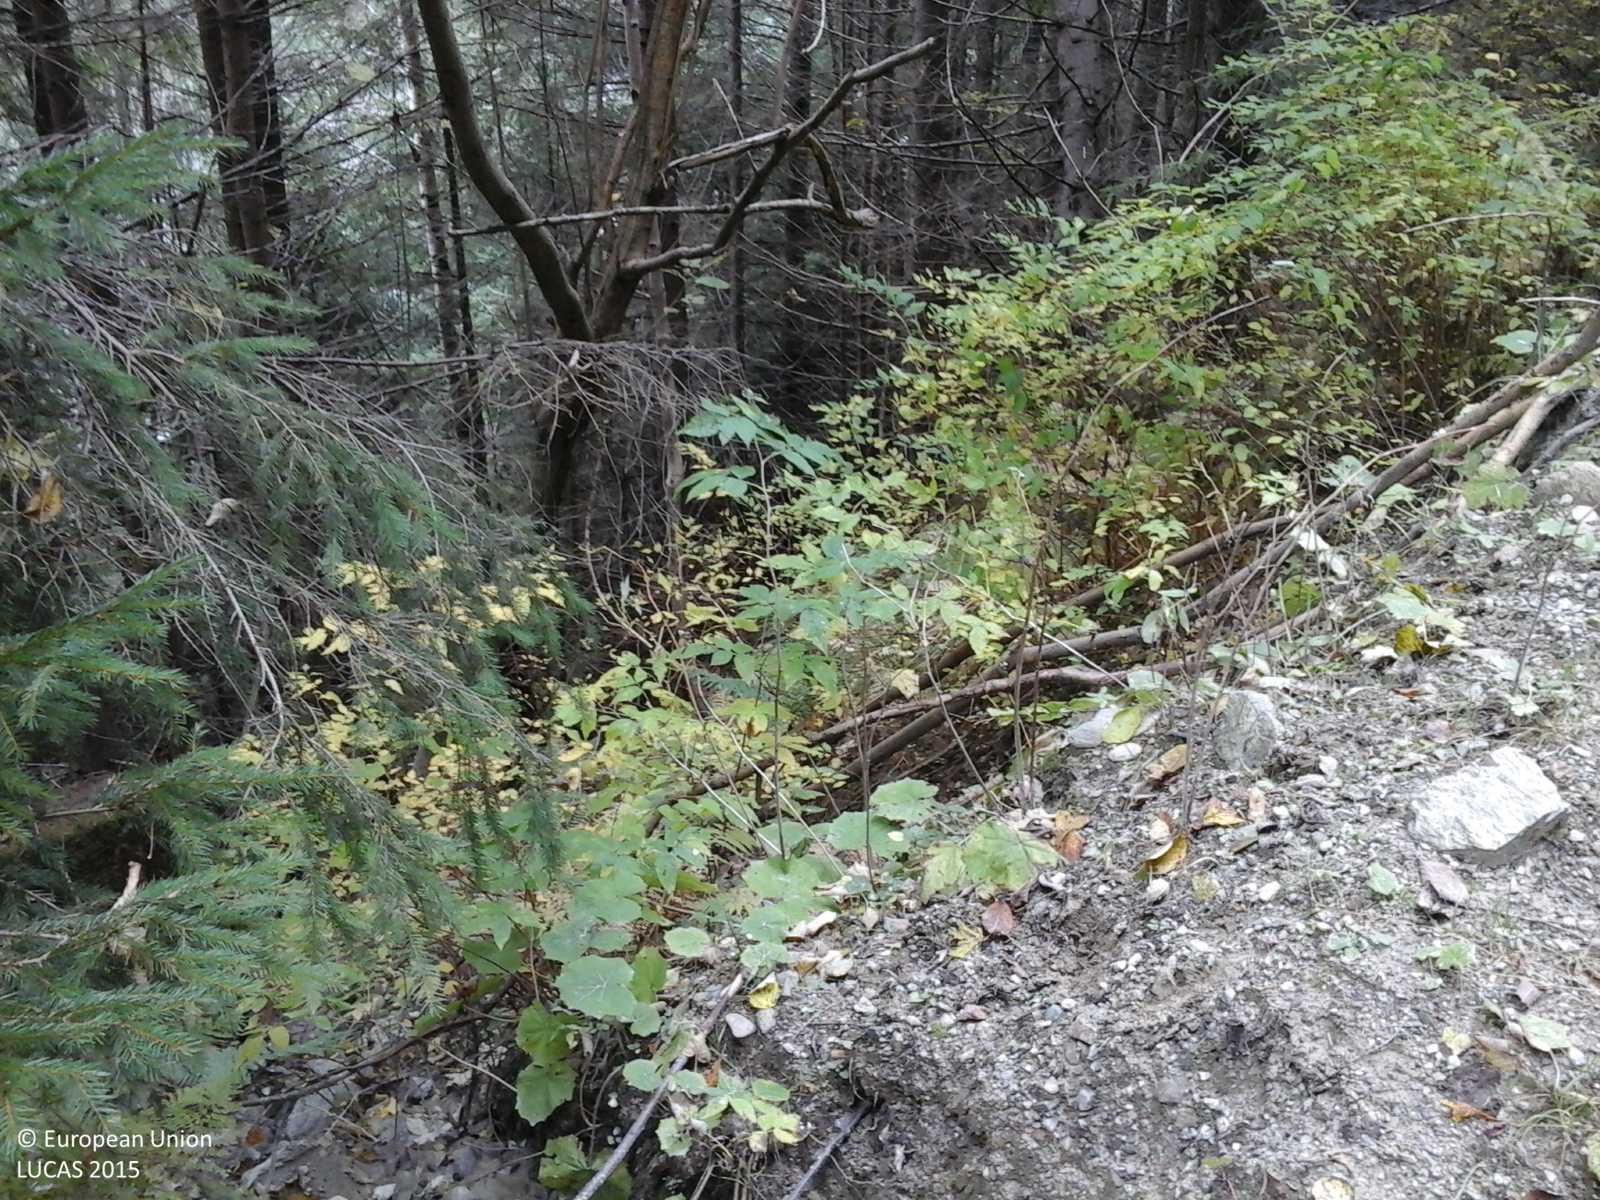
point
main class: Woodland
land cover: Spruce dominated mixed woodland
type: alpine coniferous forest
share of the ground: > 75 %
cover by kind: coniferous forest trees 75 %, broadleaved forest trees 25 %
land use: Forestry
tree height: > 5 m
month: October
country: RO
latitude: 45.5688
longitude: 25.0706
